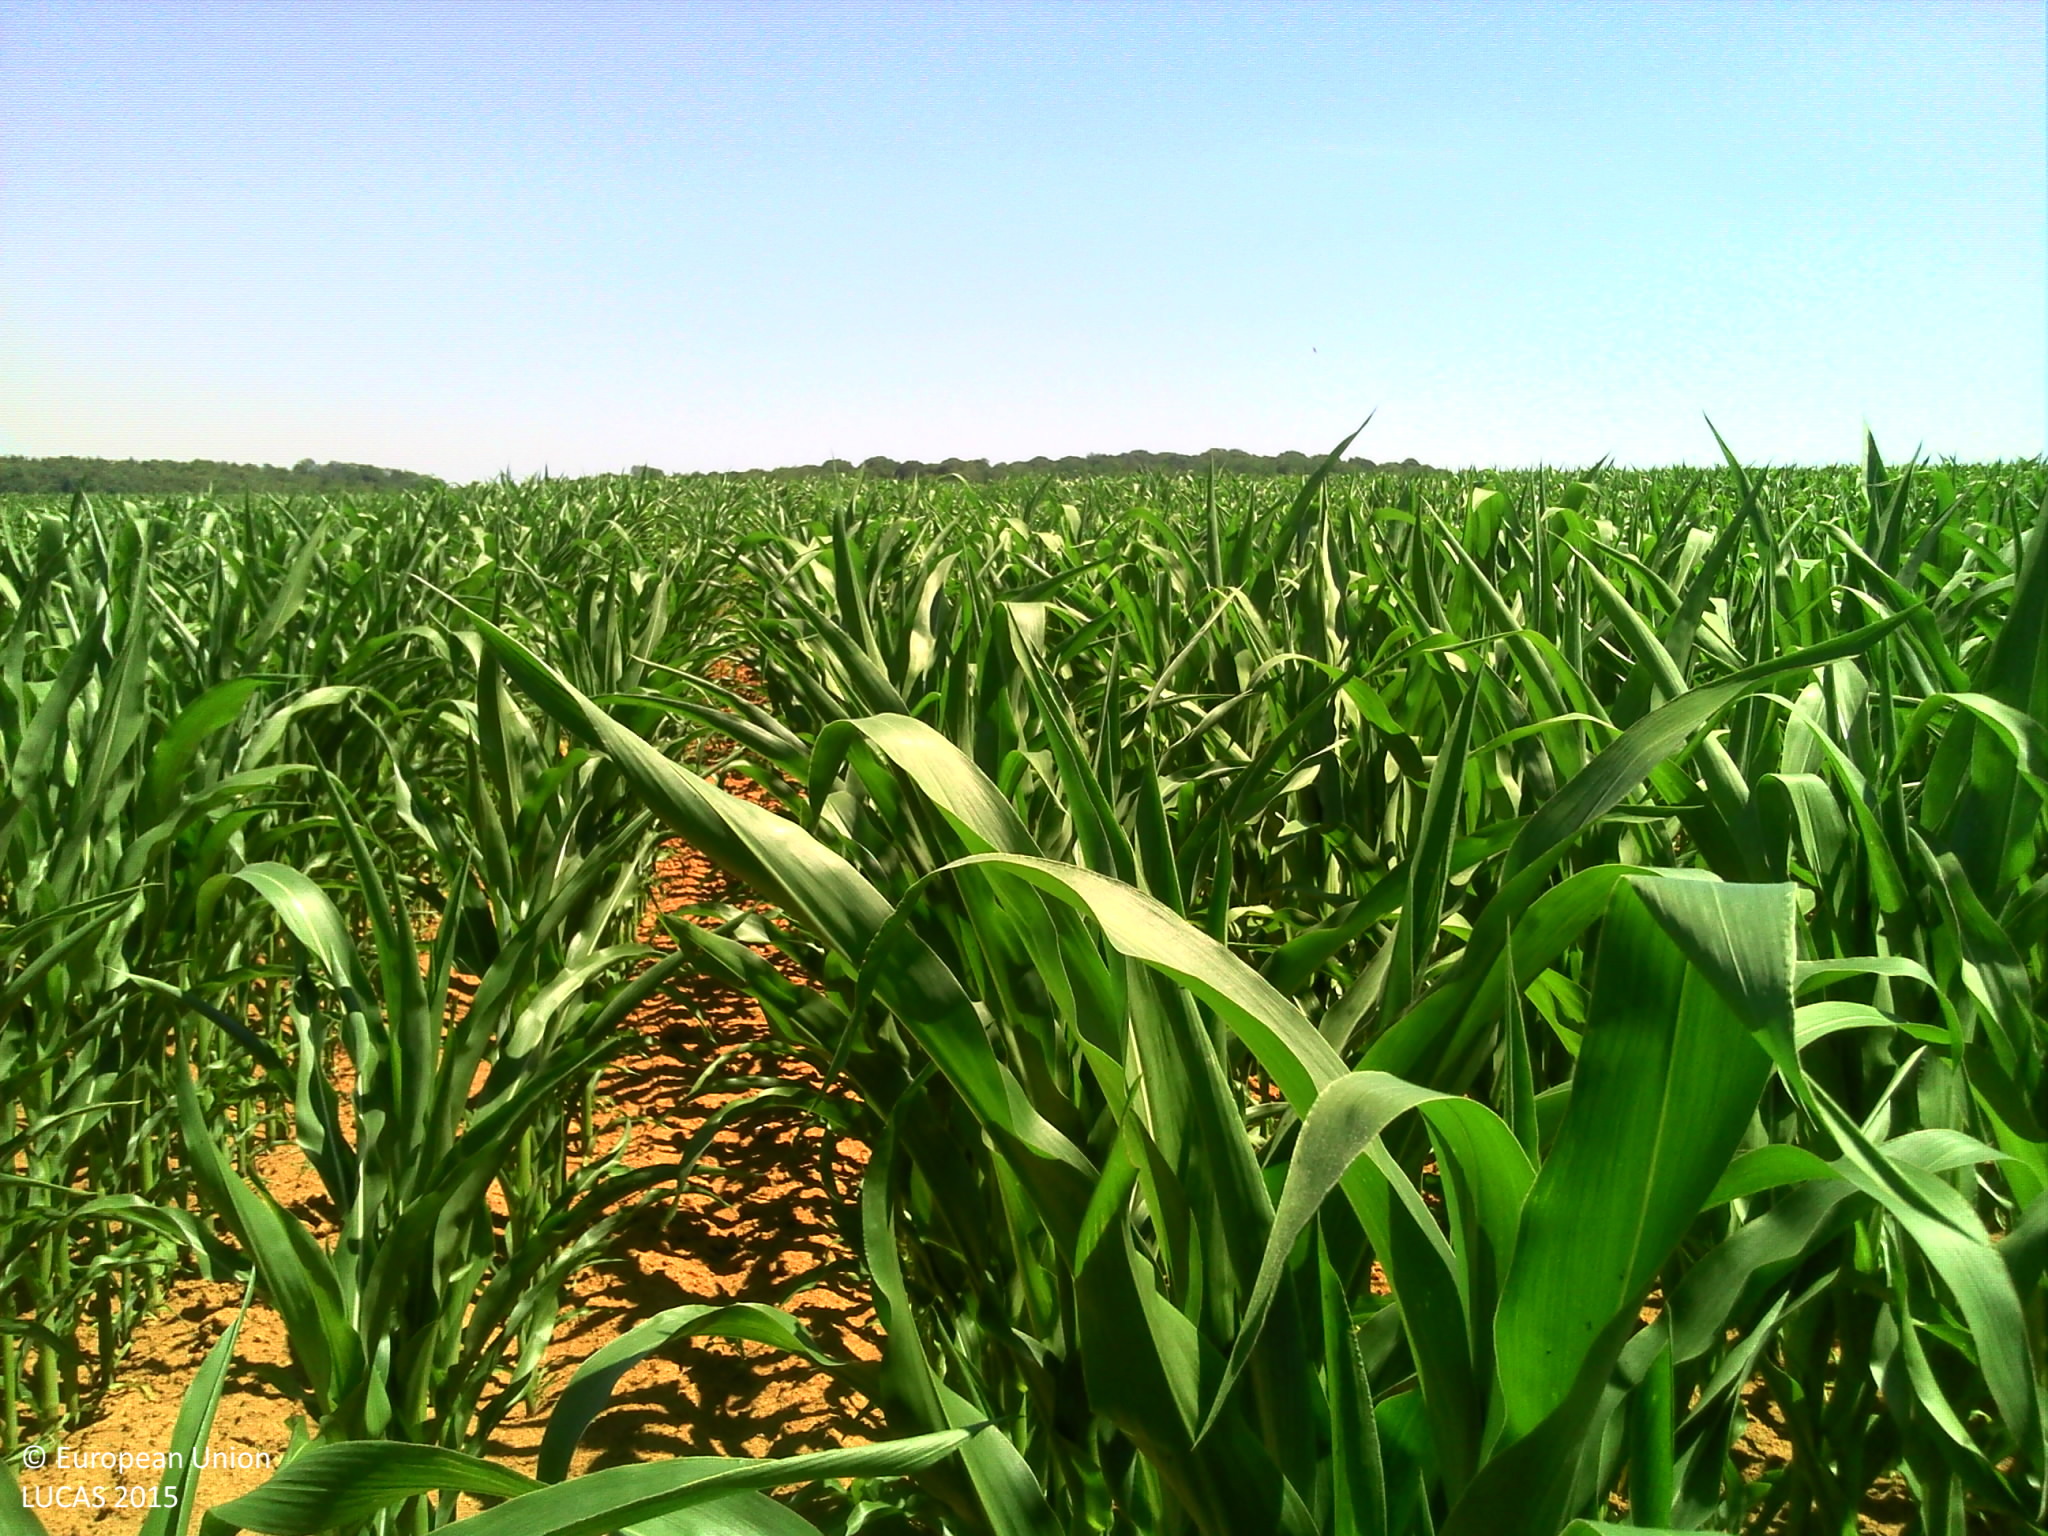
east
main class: Cropland
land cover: Maize
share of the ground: 50 - 75 %
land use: Agriculture (excluding fallow land and kitchen gardens)
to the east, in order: Maize
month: July
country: FR
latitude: 48.8910
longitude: 5.1291
